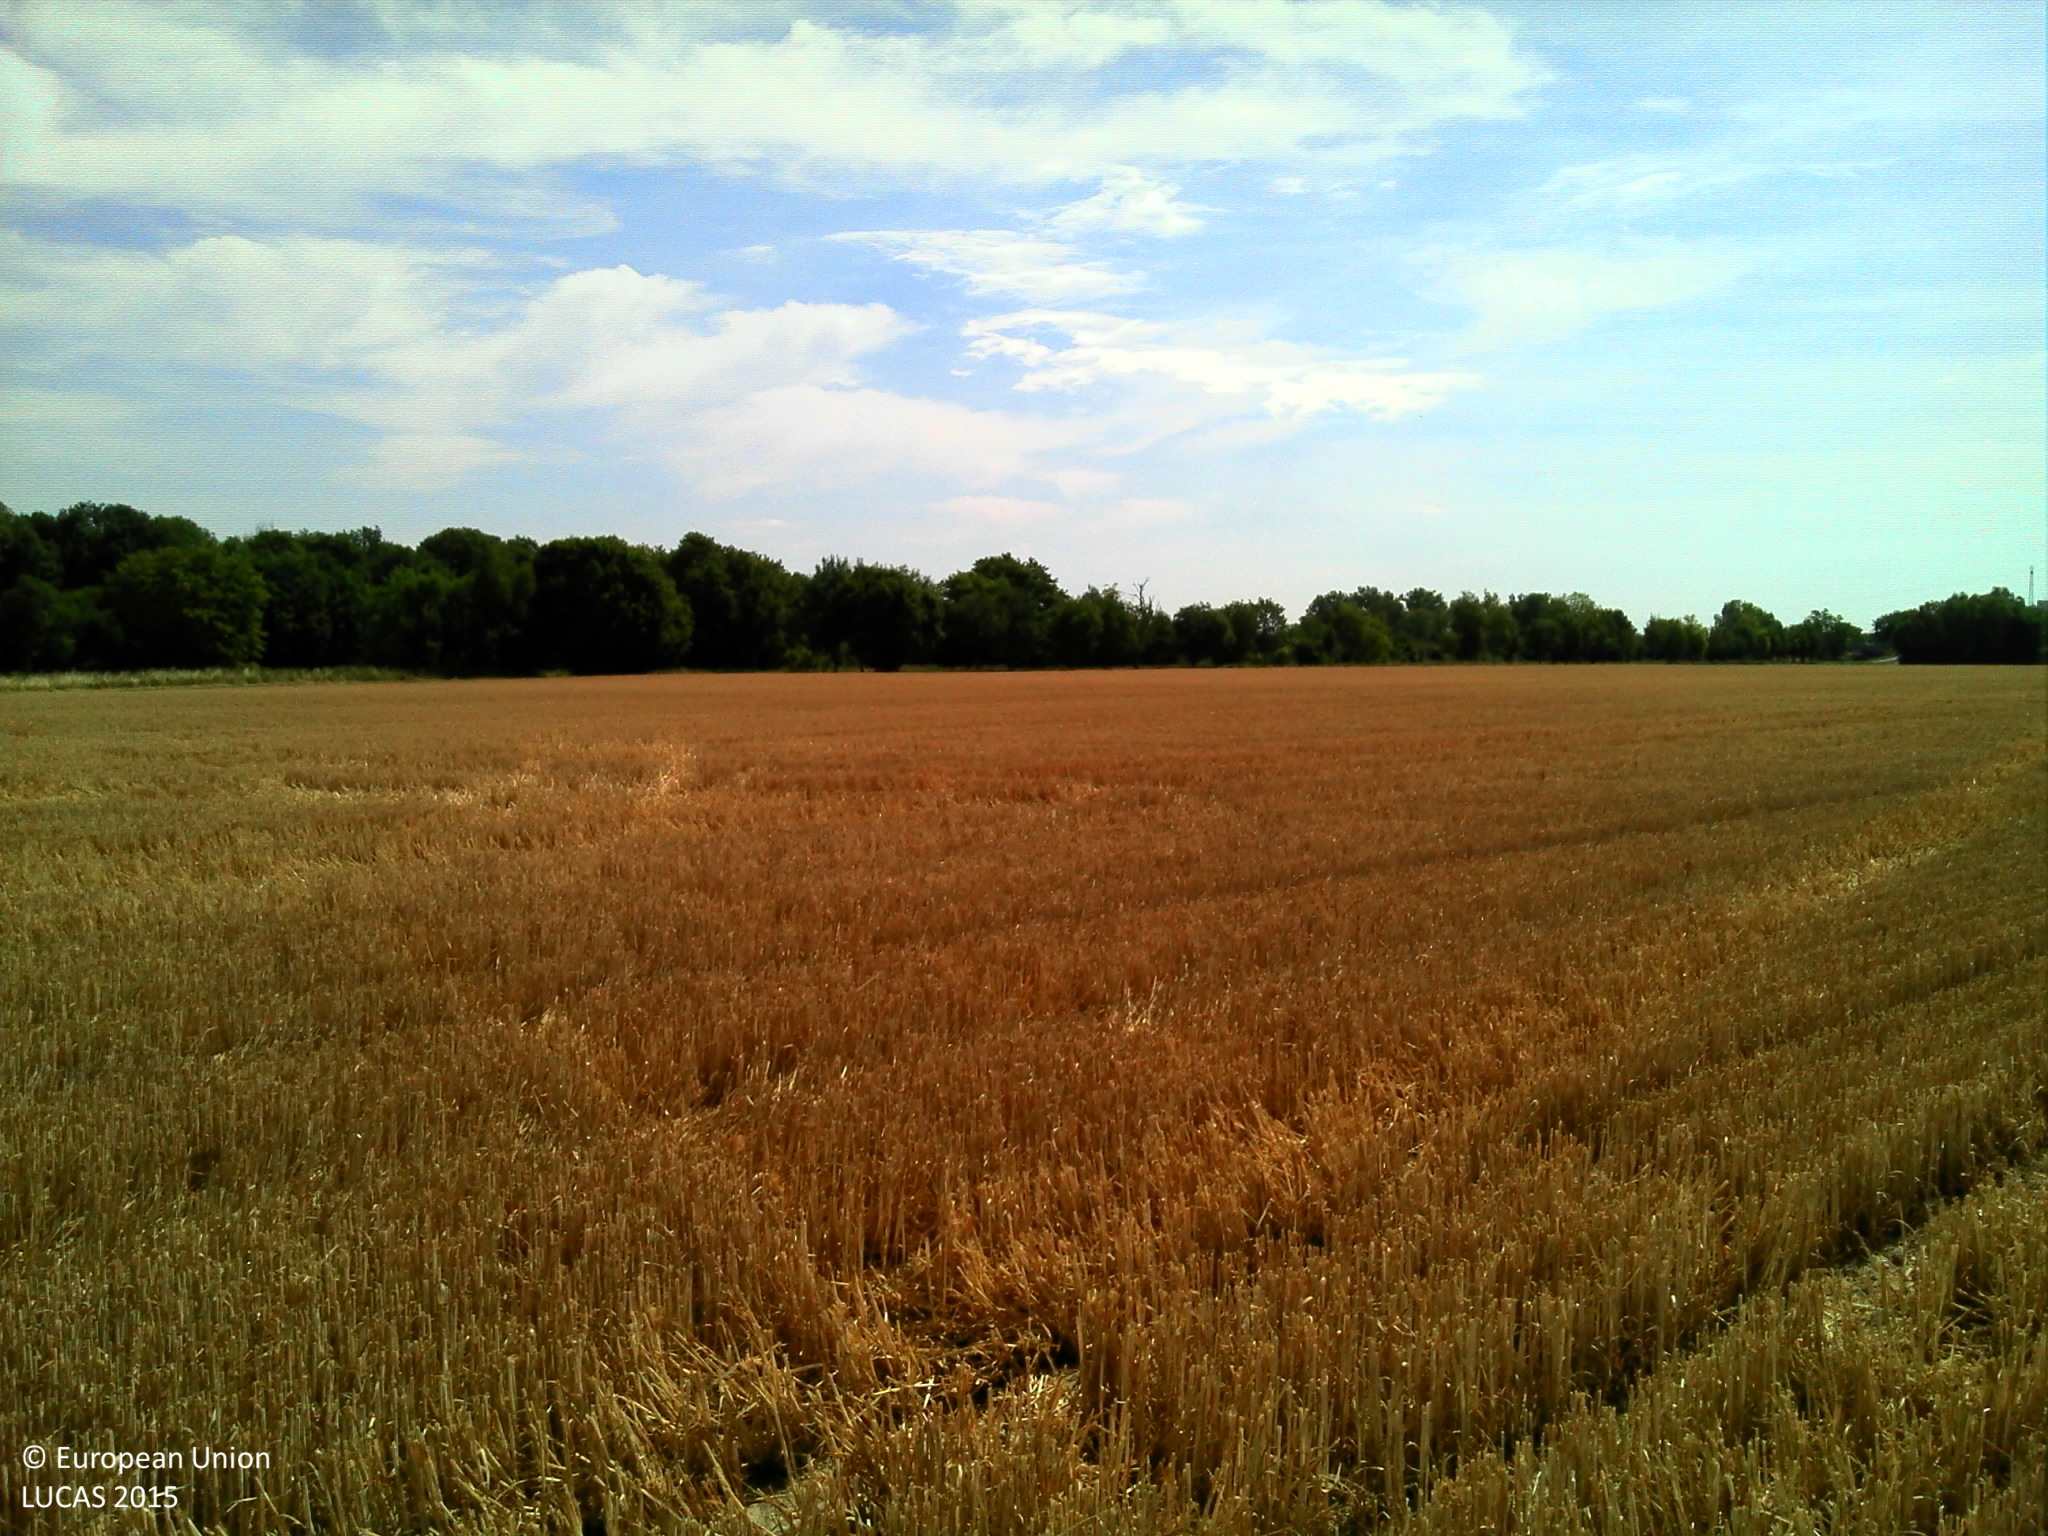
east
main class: Cropland
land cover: Common wheat
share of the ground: > 75 %
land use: Agriculture (excluding fallow land and kitchen gardens)
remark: Harvested field
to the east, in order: Common wheat; Grass margins; Tracks; Grass margins; Lines of trees; Grassland without tree/shrub cover; Paved roads, cycling and walking lanes; Grass margins; Inland fresh running water; Grass margins; Broadleaved woodland
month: August
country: FR
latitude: 49.1708
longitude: 4.1938
